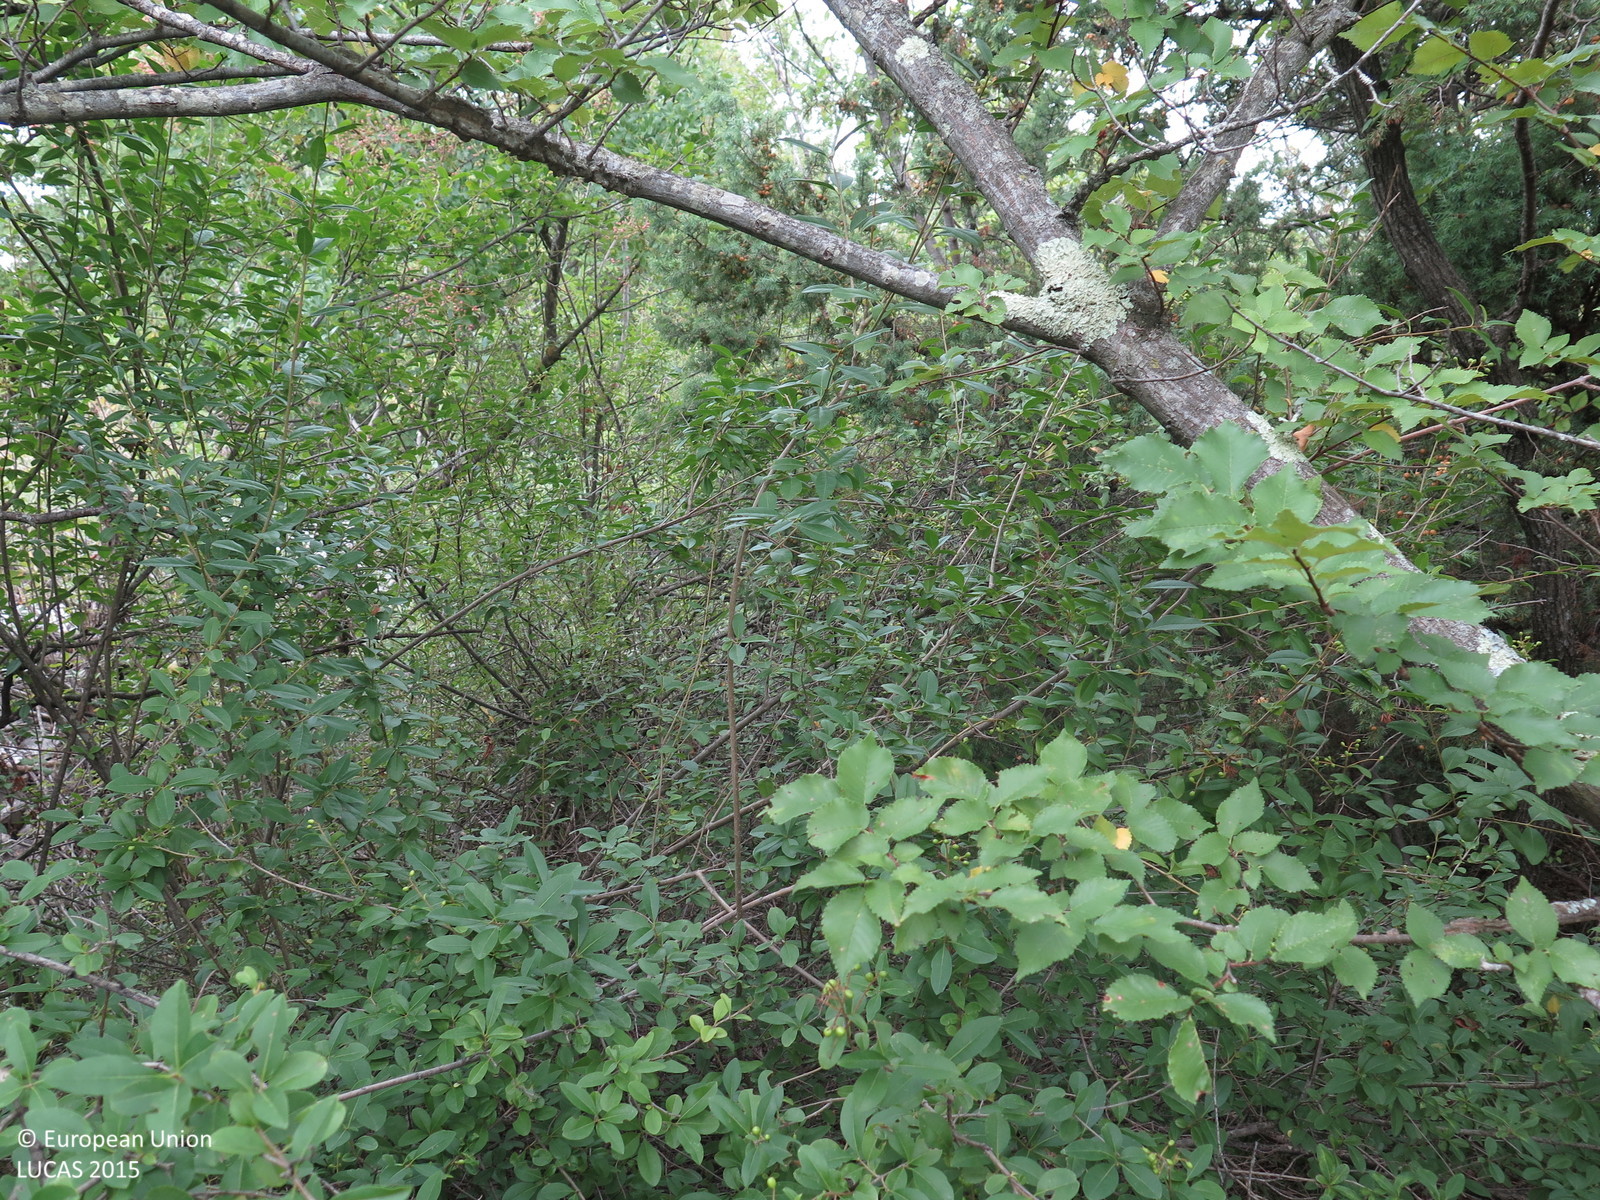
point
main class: Woodland
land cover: Broadleaved woodland
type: thermophilous deciduous forest
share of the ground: > 75 %
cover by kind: broadleaved forest trees 90 %, shrubs 5 %, herbaceous plants 5 %
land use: Abandoned areas
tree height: < 5 m
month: August
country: HR
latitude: 45.1307
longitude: 14.6609
